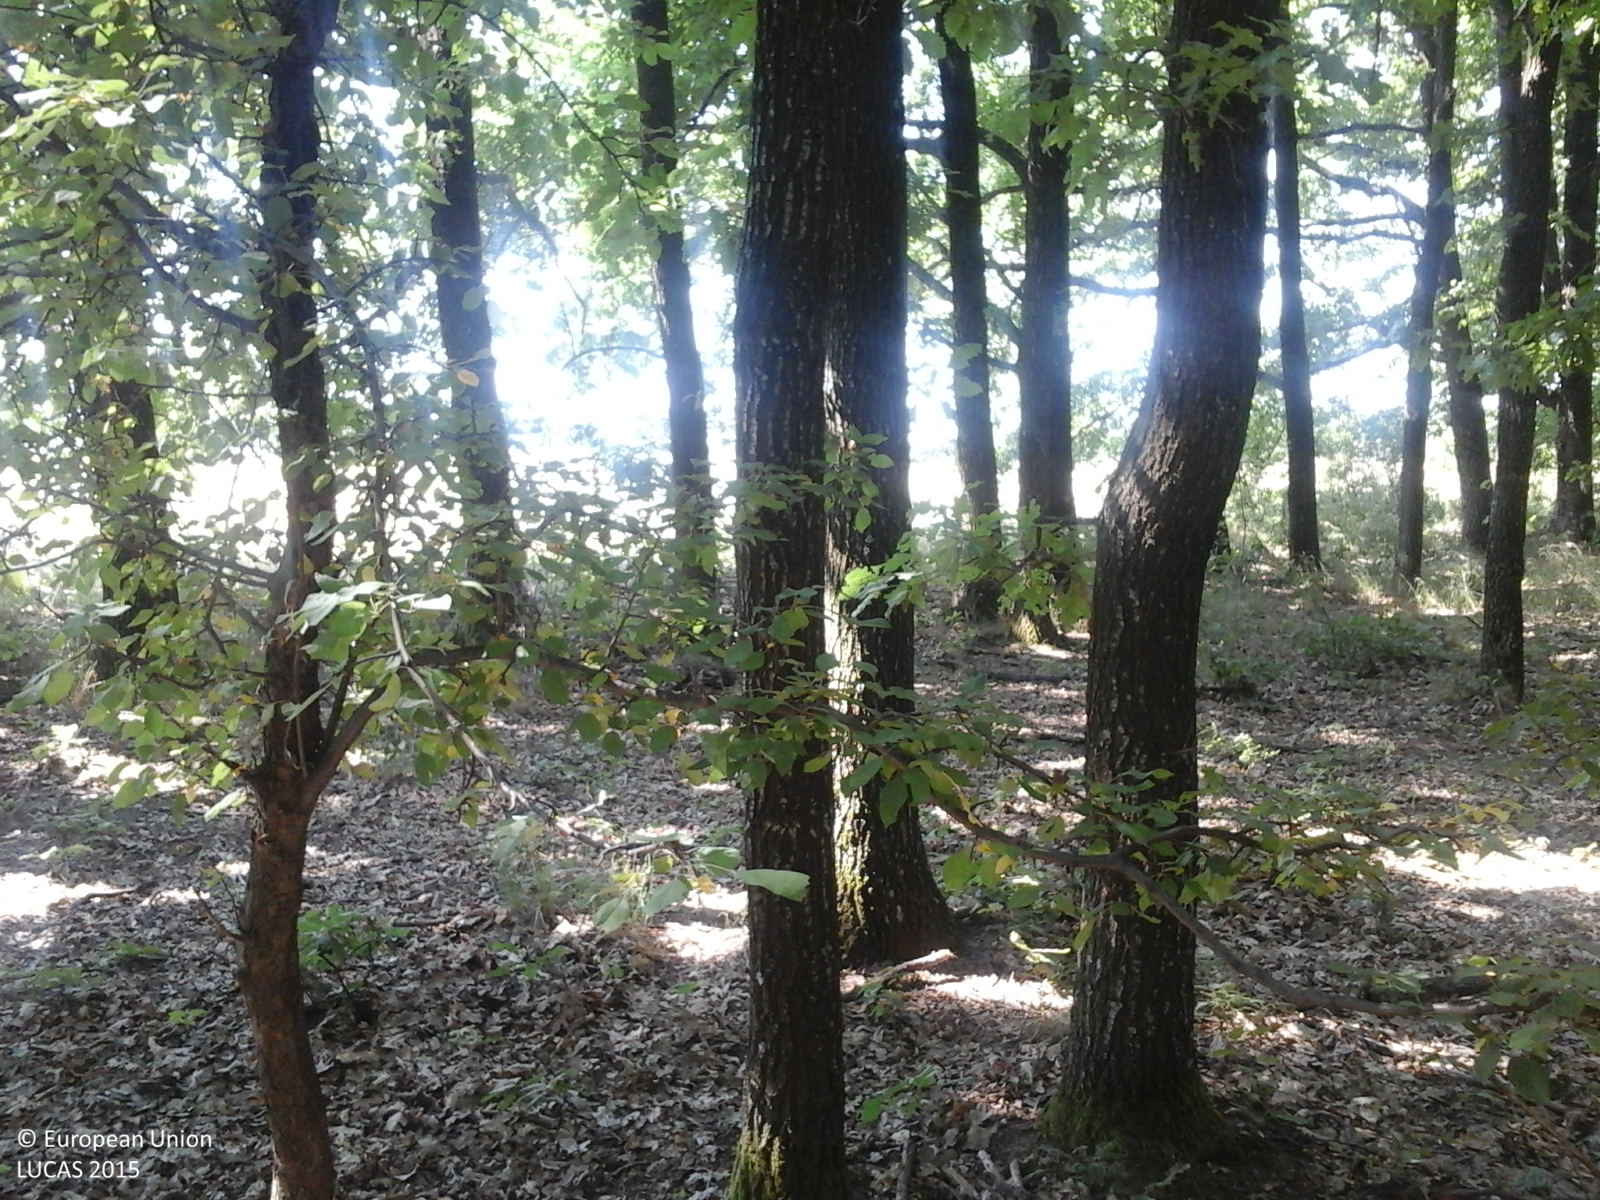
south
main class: Woodland
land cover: Broadleaved woodland
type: acidophilous oak and oak-birch forest
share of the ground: > 75 %
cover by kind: broadleaved forest trees 100 %
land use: Forestry
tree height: > 5 m
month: July
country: RO
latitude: 44.8186
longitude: 24.5546
